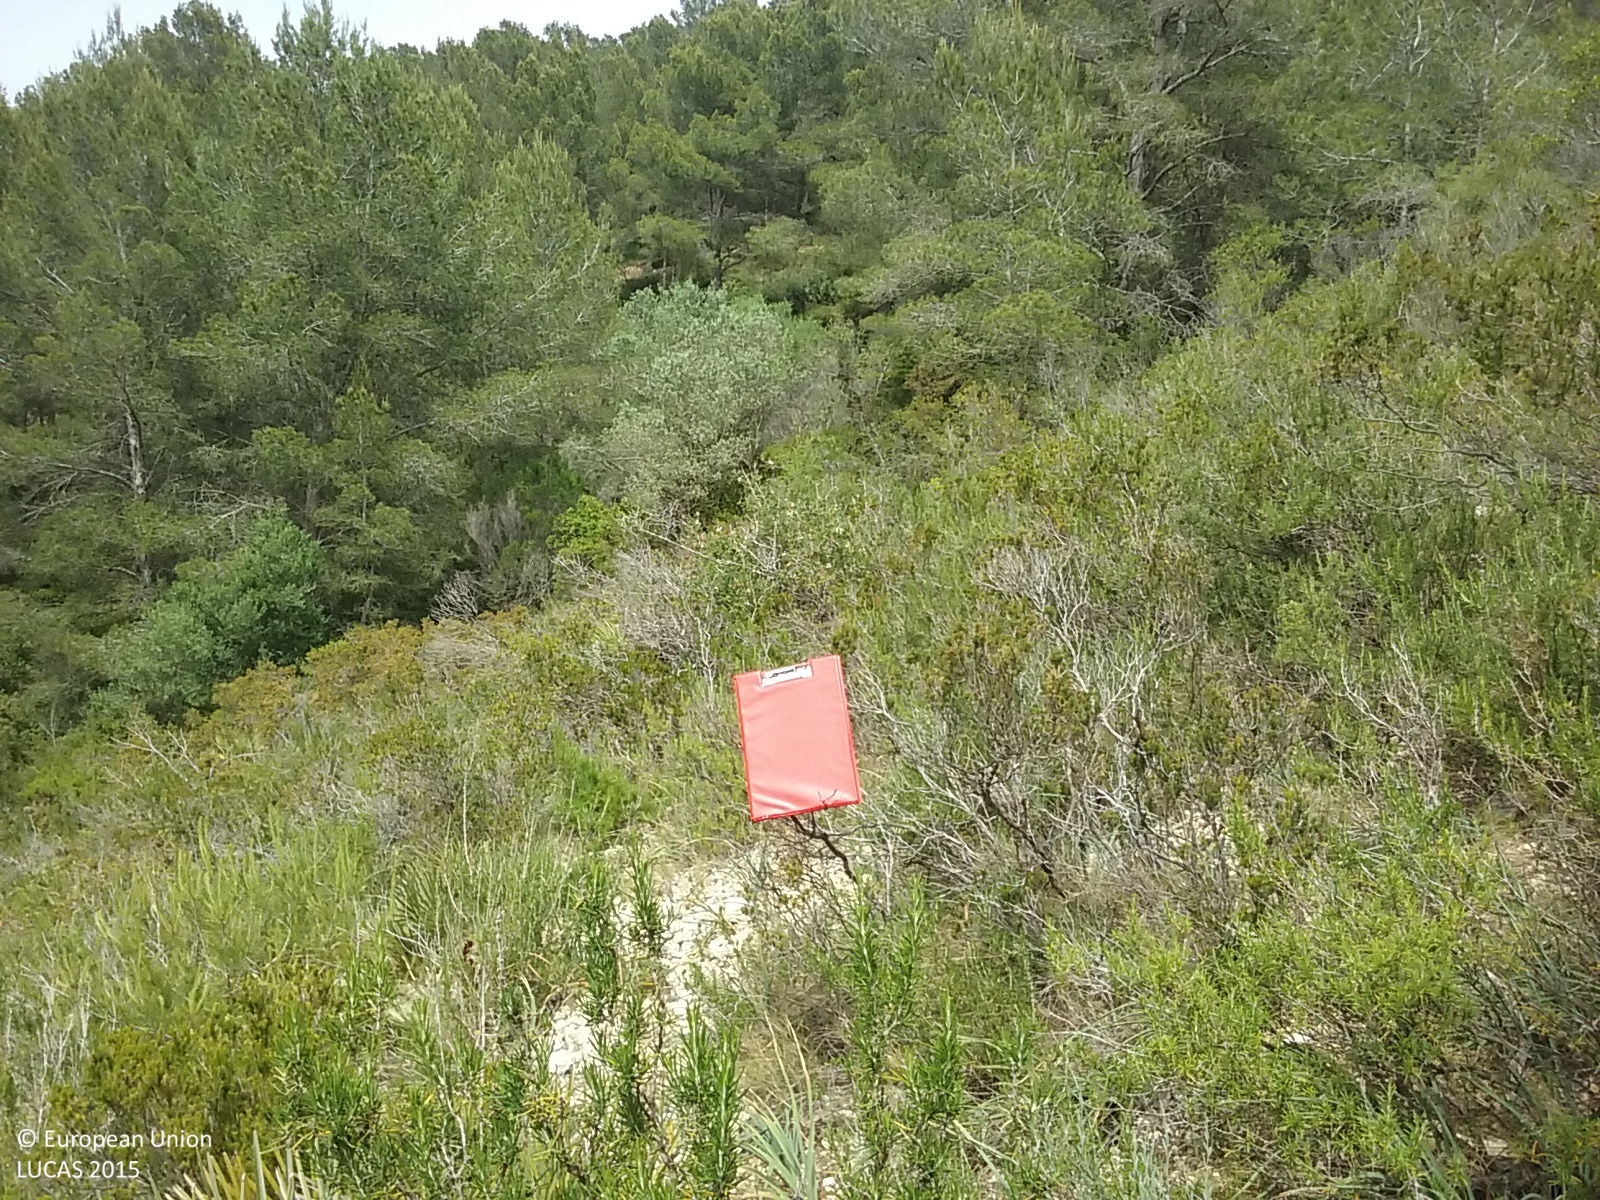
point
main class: Woodland
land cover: Pine dominated coniferous woodland
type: coniferous forest of the mediterranean region
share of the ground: 10 - 25 %
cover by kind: shrubs 80 %, coniferous forest trees 15 %, herbaceous plants 5 %
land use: Semi-natural and natural areas not in use
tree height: > 5 m
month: May
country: ES
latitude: 40.8131
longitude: 0.5692
